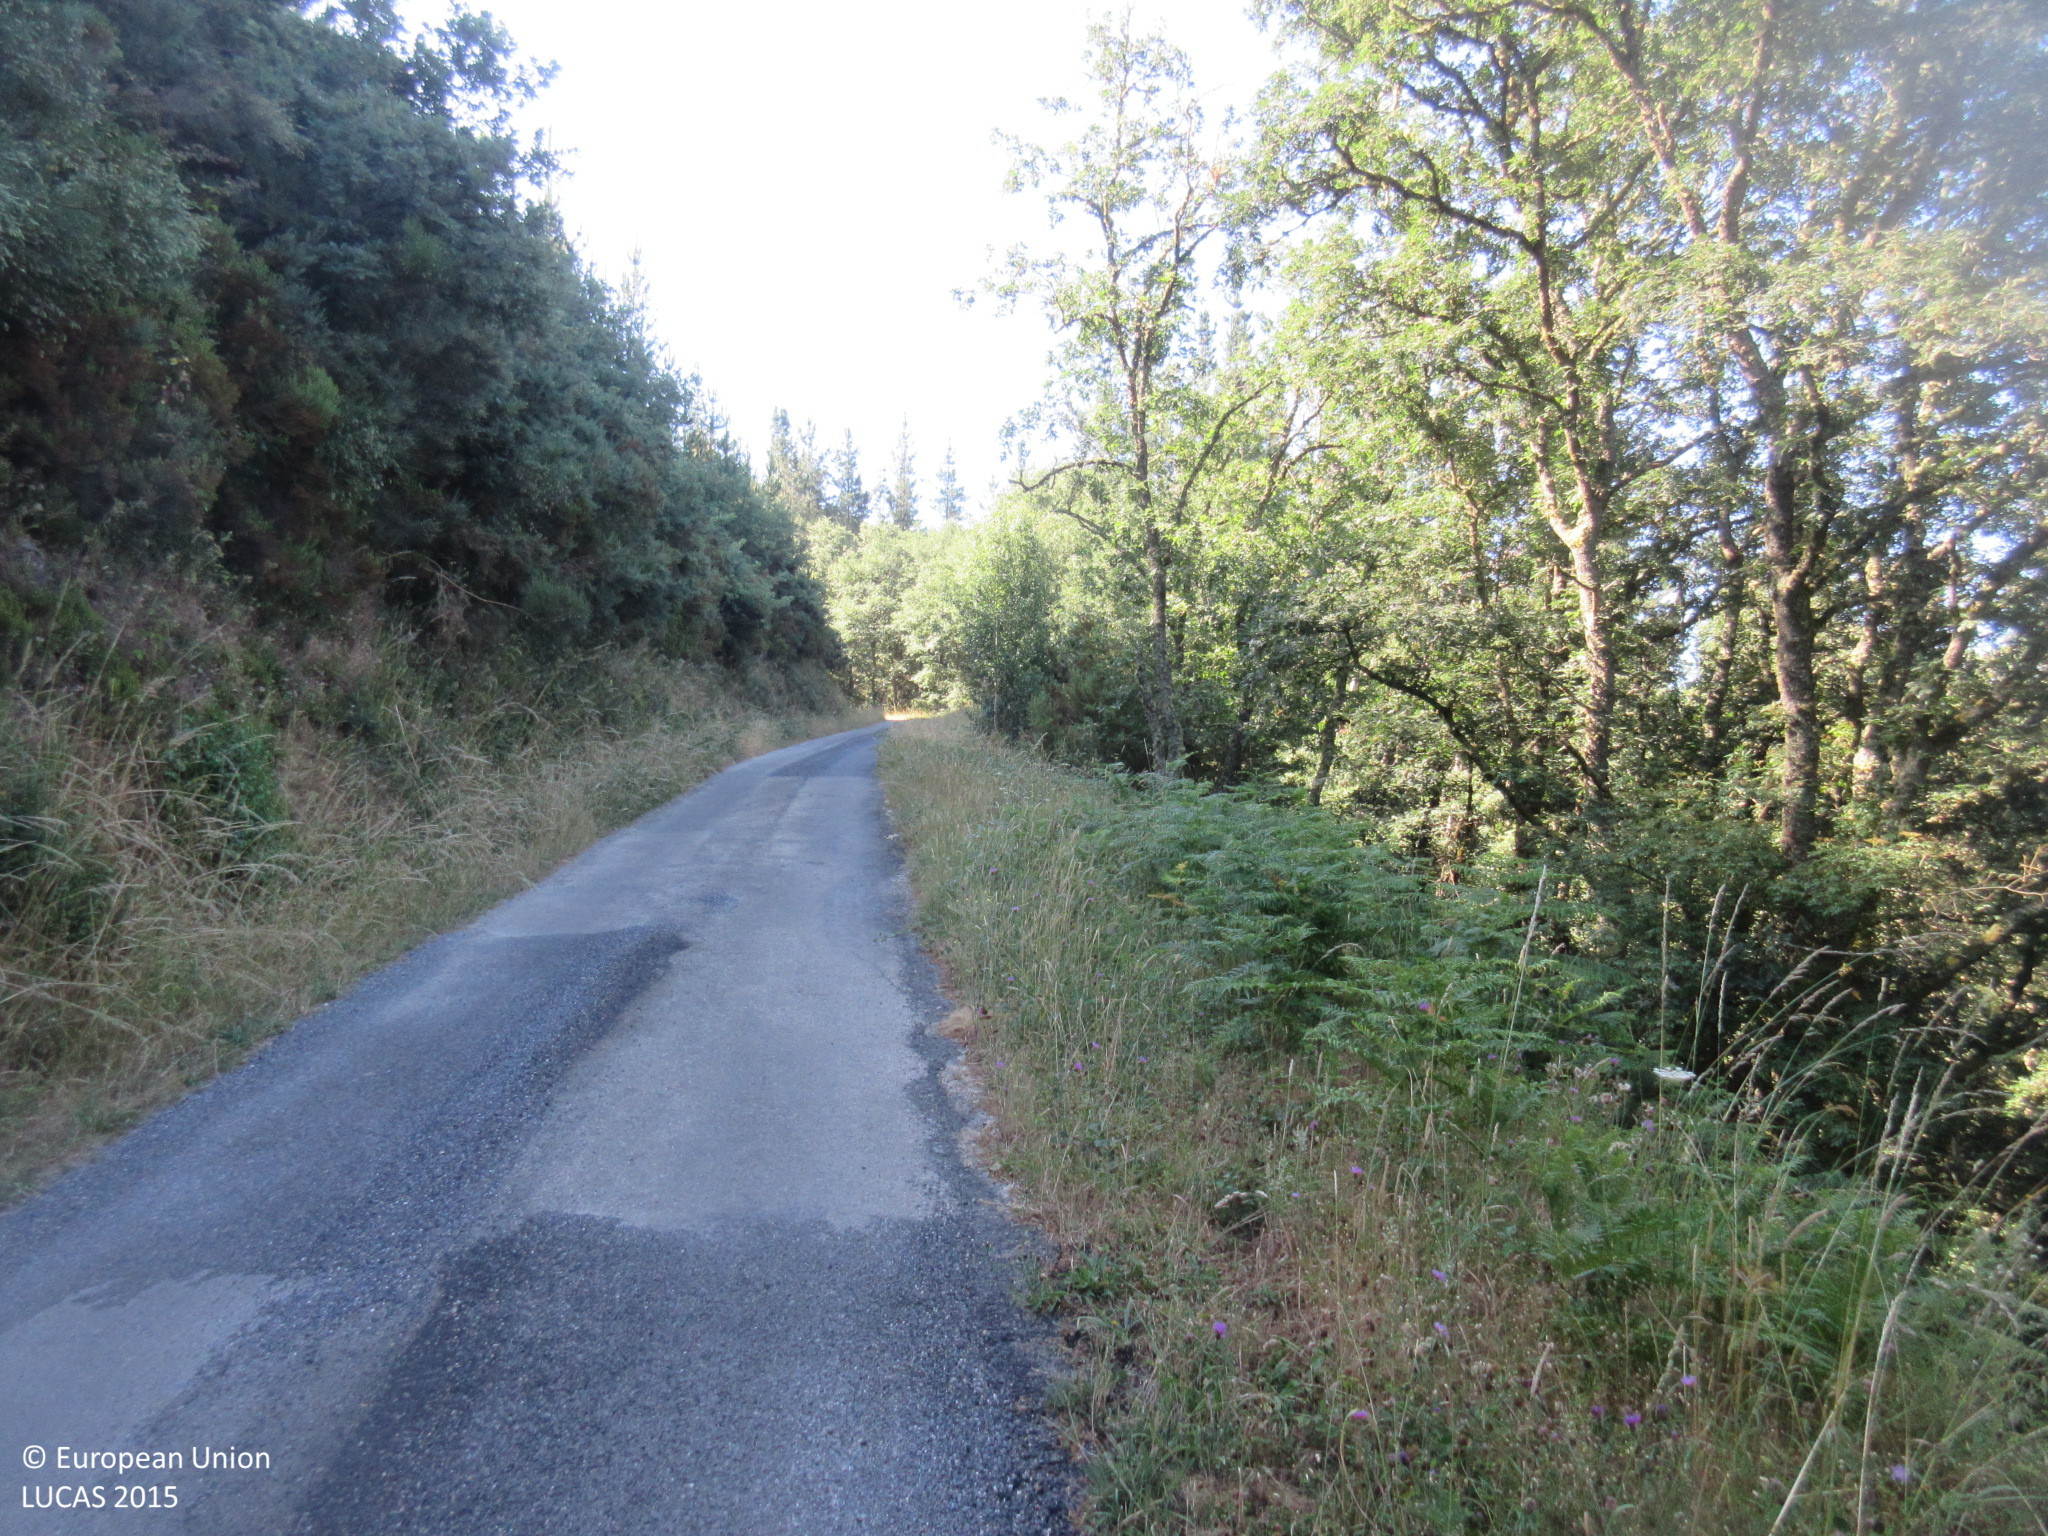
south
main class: Woodland
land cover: Broadleaved woodland
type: acidophilous oak and oak-birch forest
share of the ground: > 75 %
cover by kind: broadleaved forest trees 90 %, shrubs 10 %
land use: Forestry
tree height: > 5 m
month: June
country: ES
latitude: 43.2008
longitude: -7.0619
